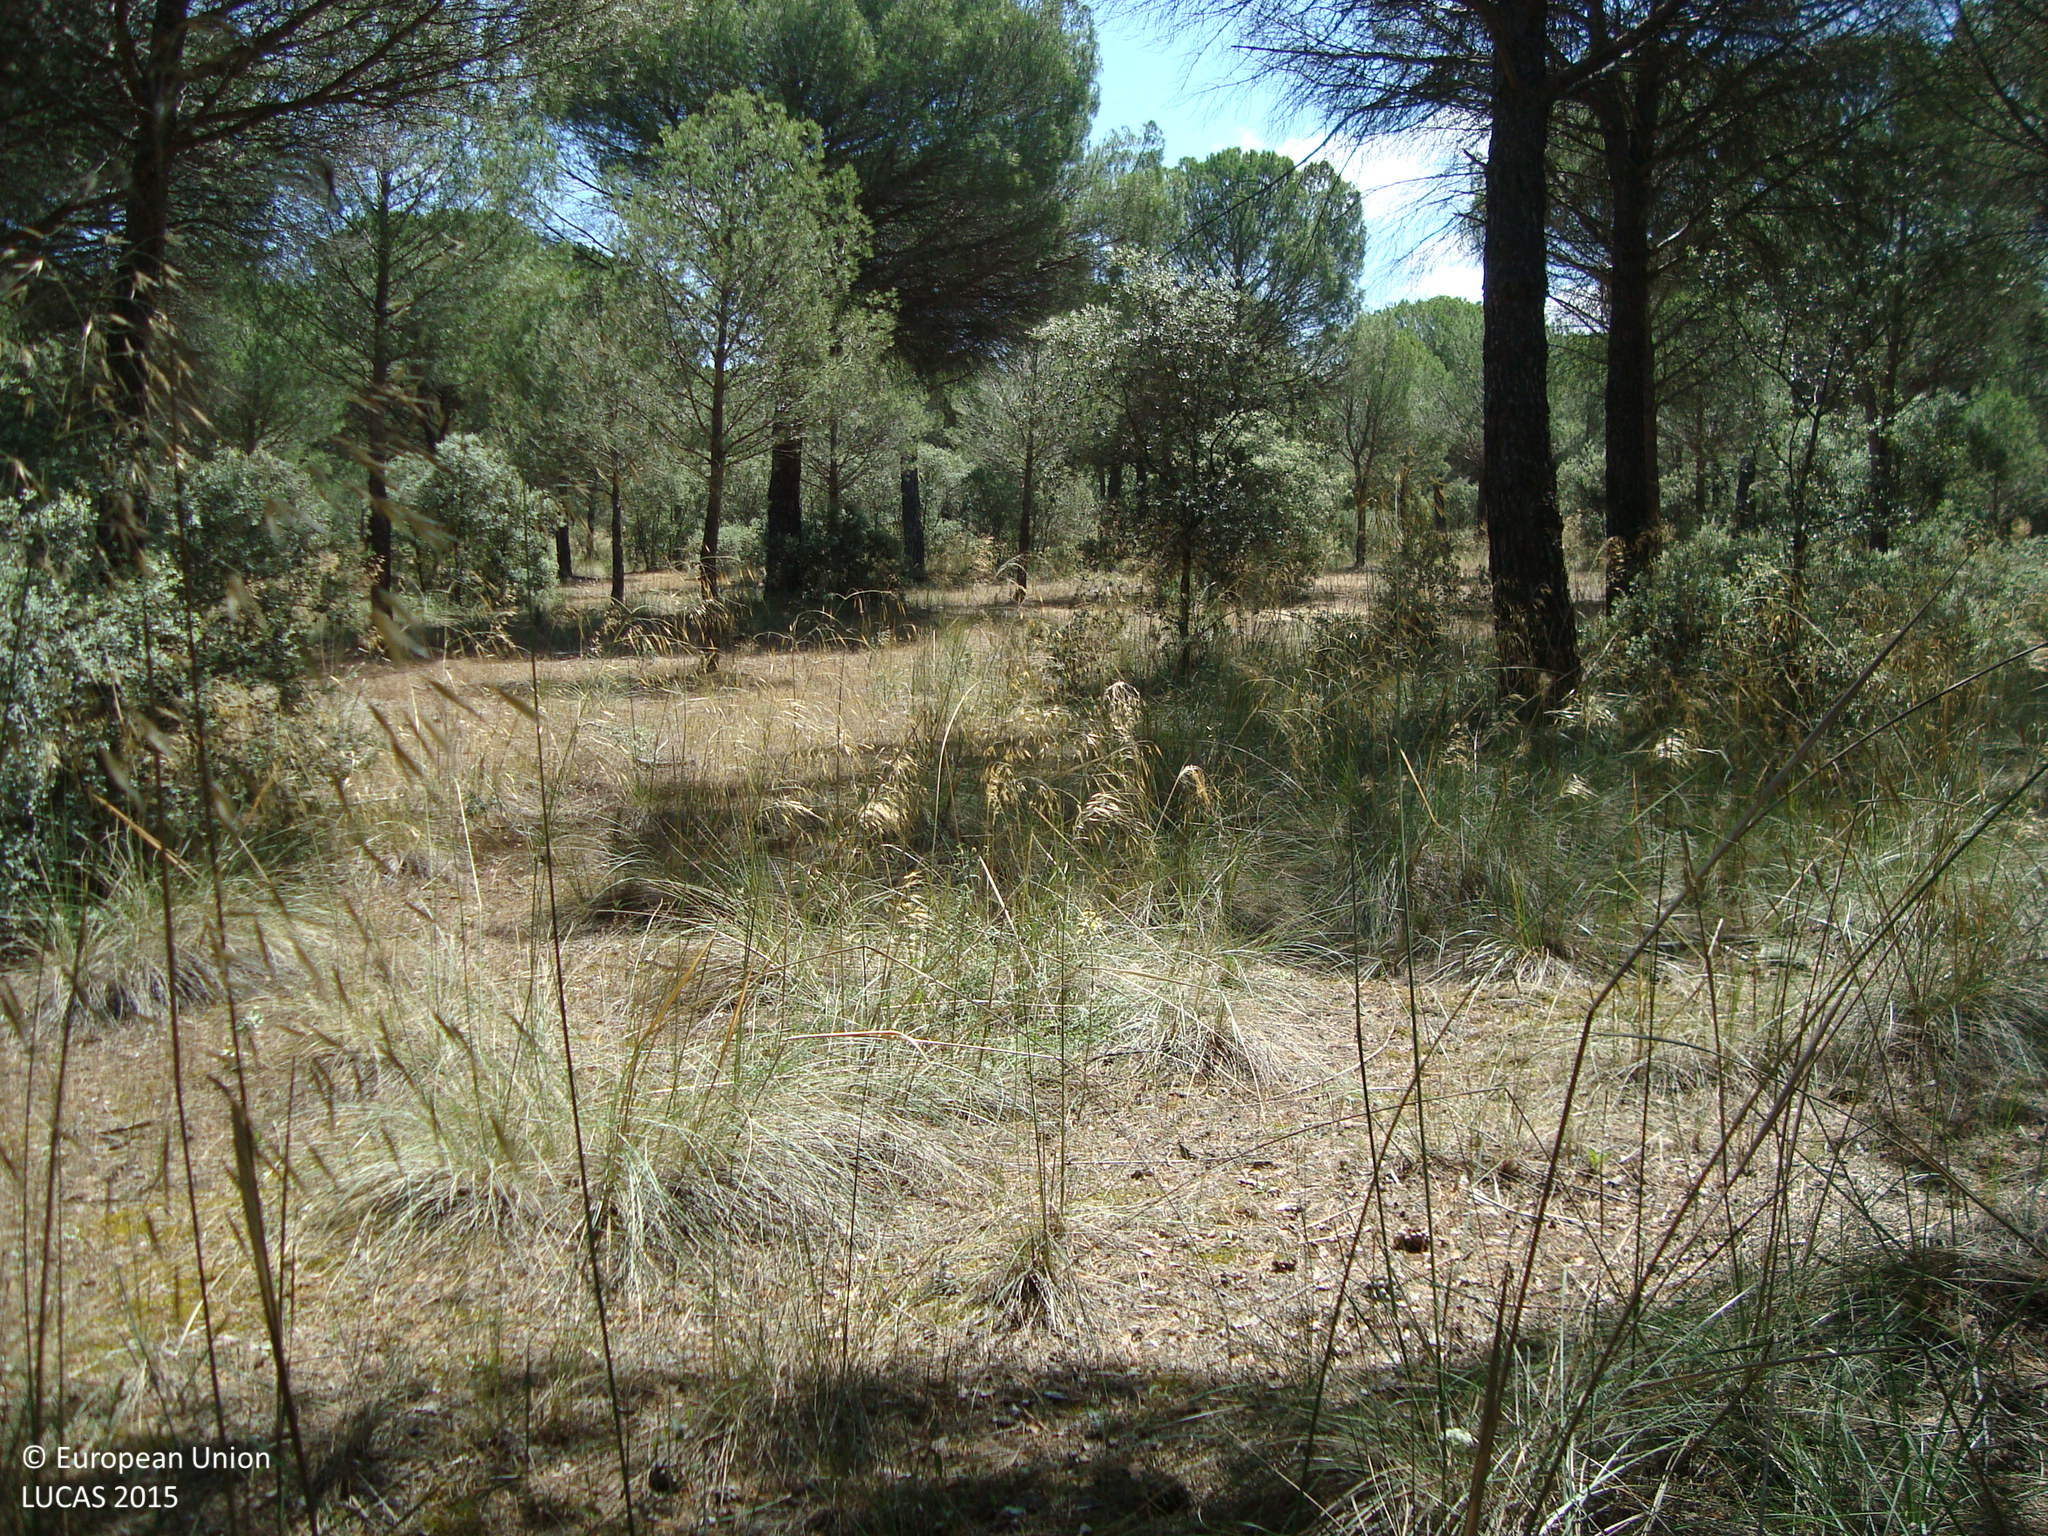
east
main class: Woodland
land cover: Pine dominated mixed woodland
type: coniferous forest of the mediterranean region
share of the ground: 50 - 75 %
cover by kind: coniferous forest trees 60 %, broadleaved forest trees 20 %, shrubs 10 %, herbaceous plants 10 %
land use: Forestry
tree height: > 5 m
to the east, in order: Pine dominated mixed woodland
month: June
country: ES
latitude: 41.6278
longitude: -4.2119
